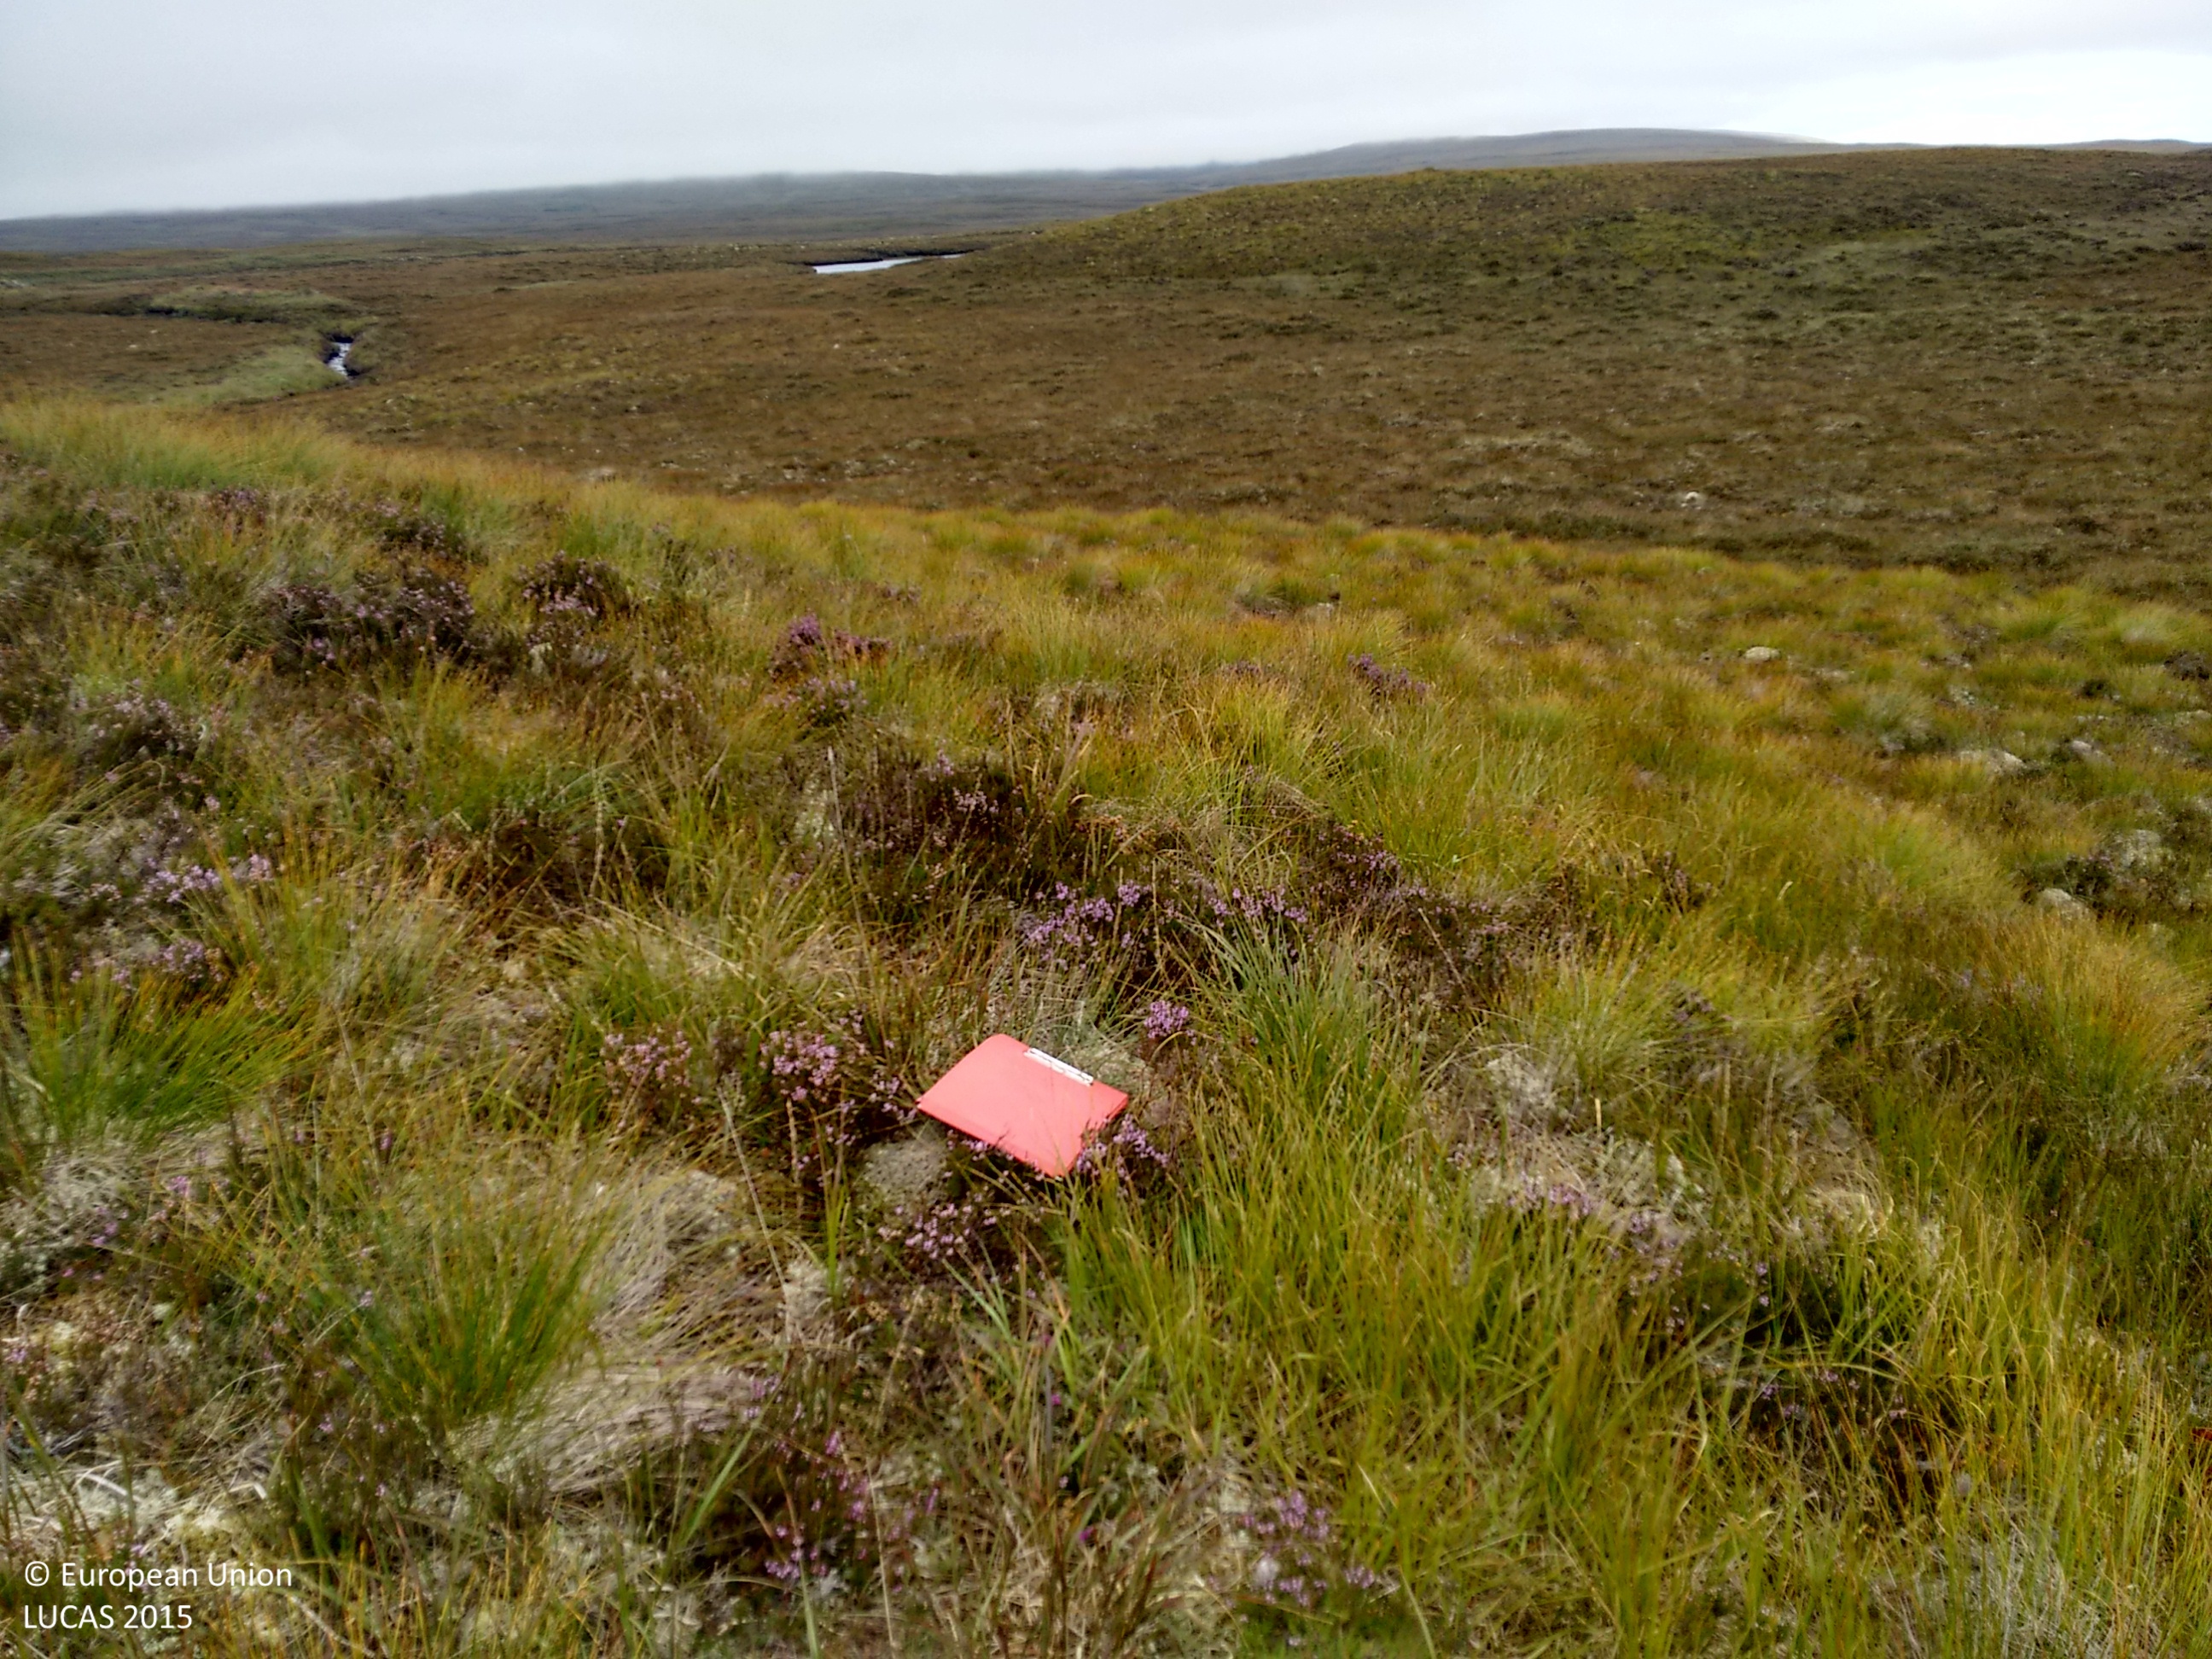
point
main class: Shrubland
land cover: Shrubland without tree cover
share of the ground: 50 - 75 %
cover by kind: shrubs 60 %, herbaceous plants 40 %
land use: Semi-natural and natural areas not in use
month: September
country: GB
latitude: 58.1935
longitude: -4.5301
